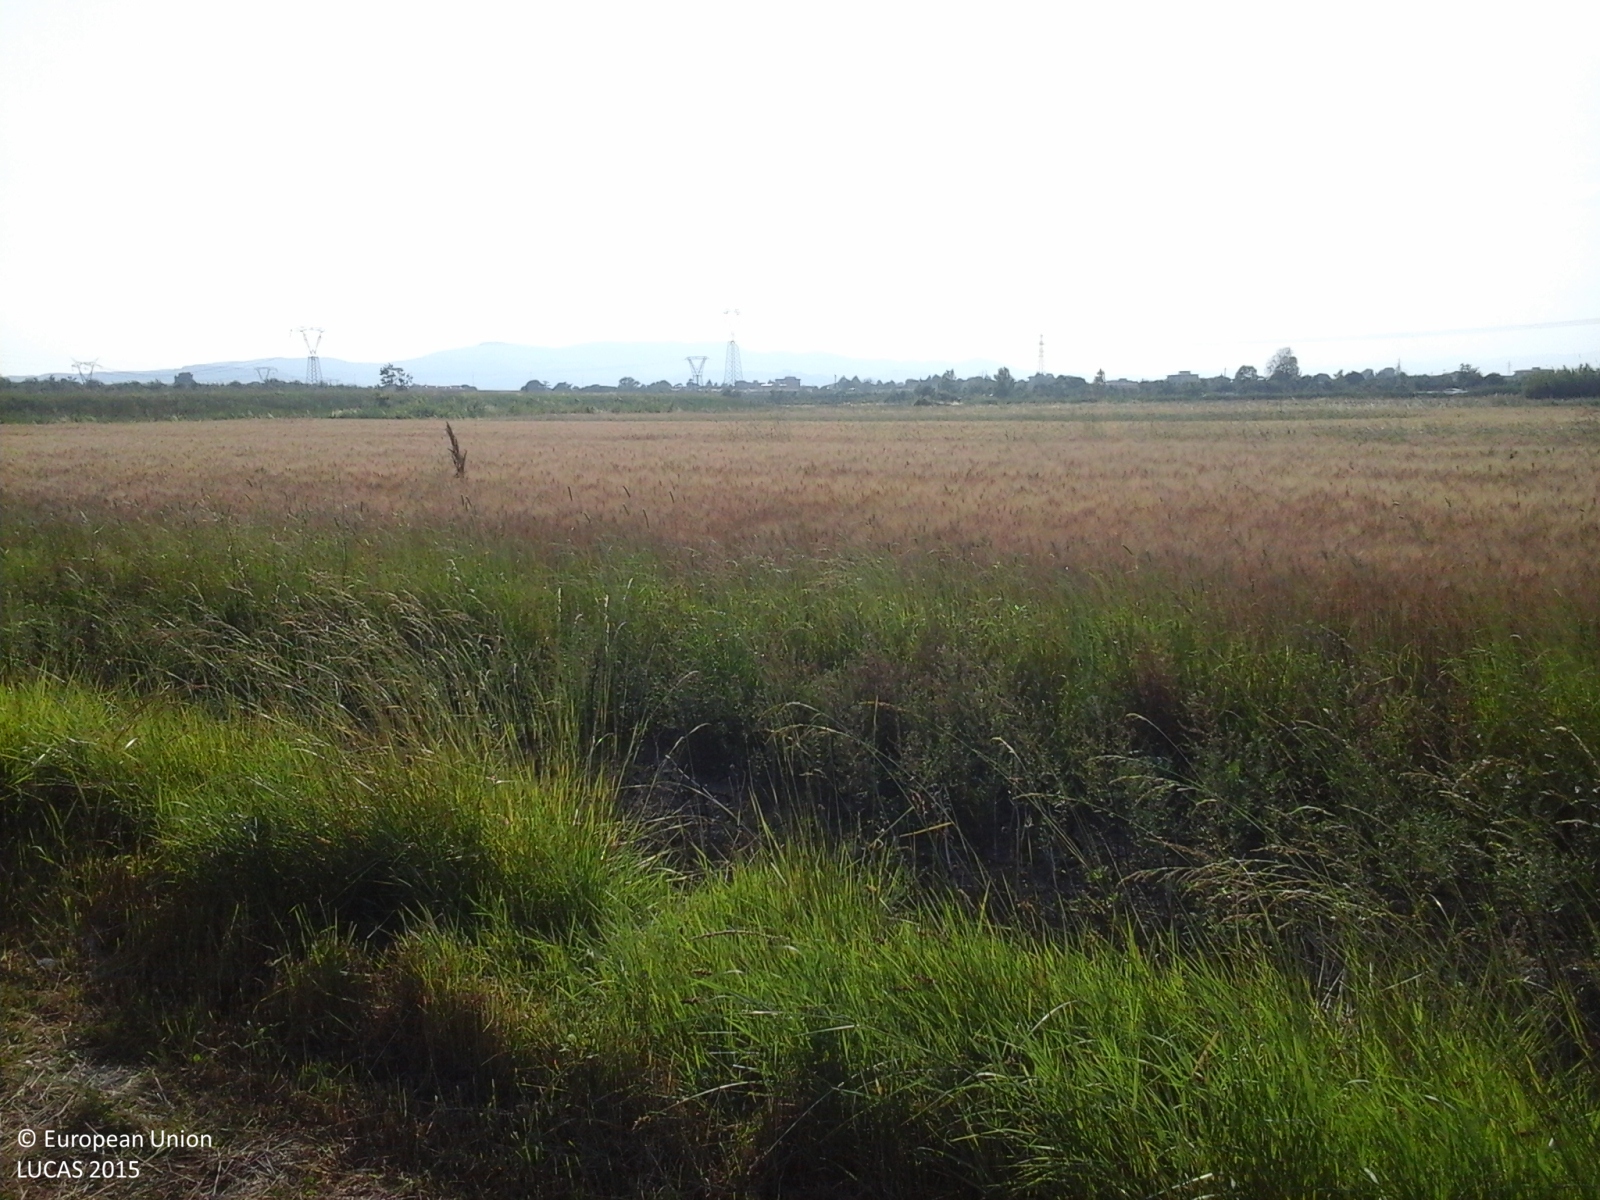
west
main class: Cropland
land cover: Durum wheat
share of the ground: > 75 %
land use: Agriculture (excluding fallow land and kitchen gardens)
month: June
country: IT
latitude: 43.8029
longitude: 11.1530
